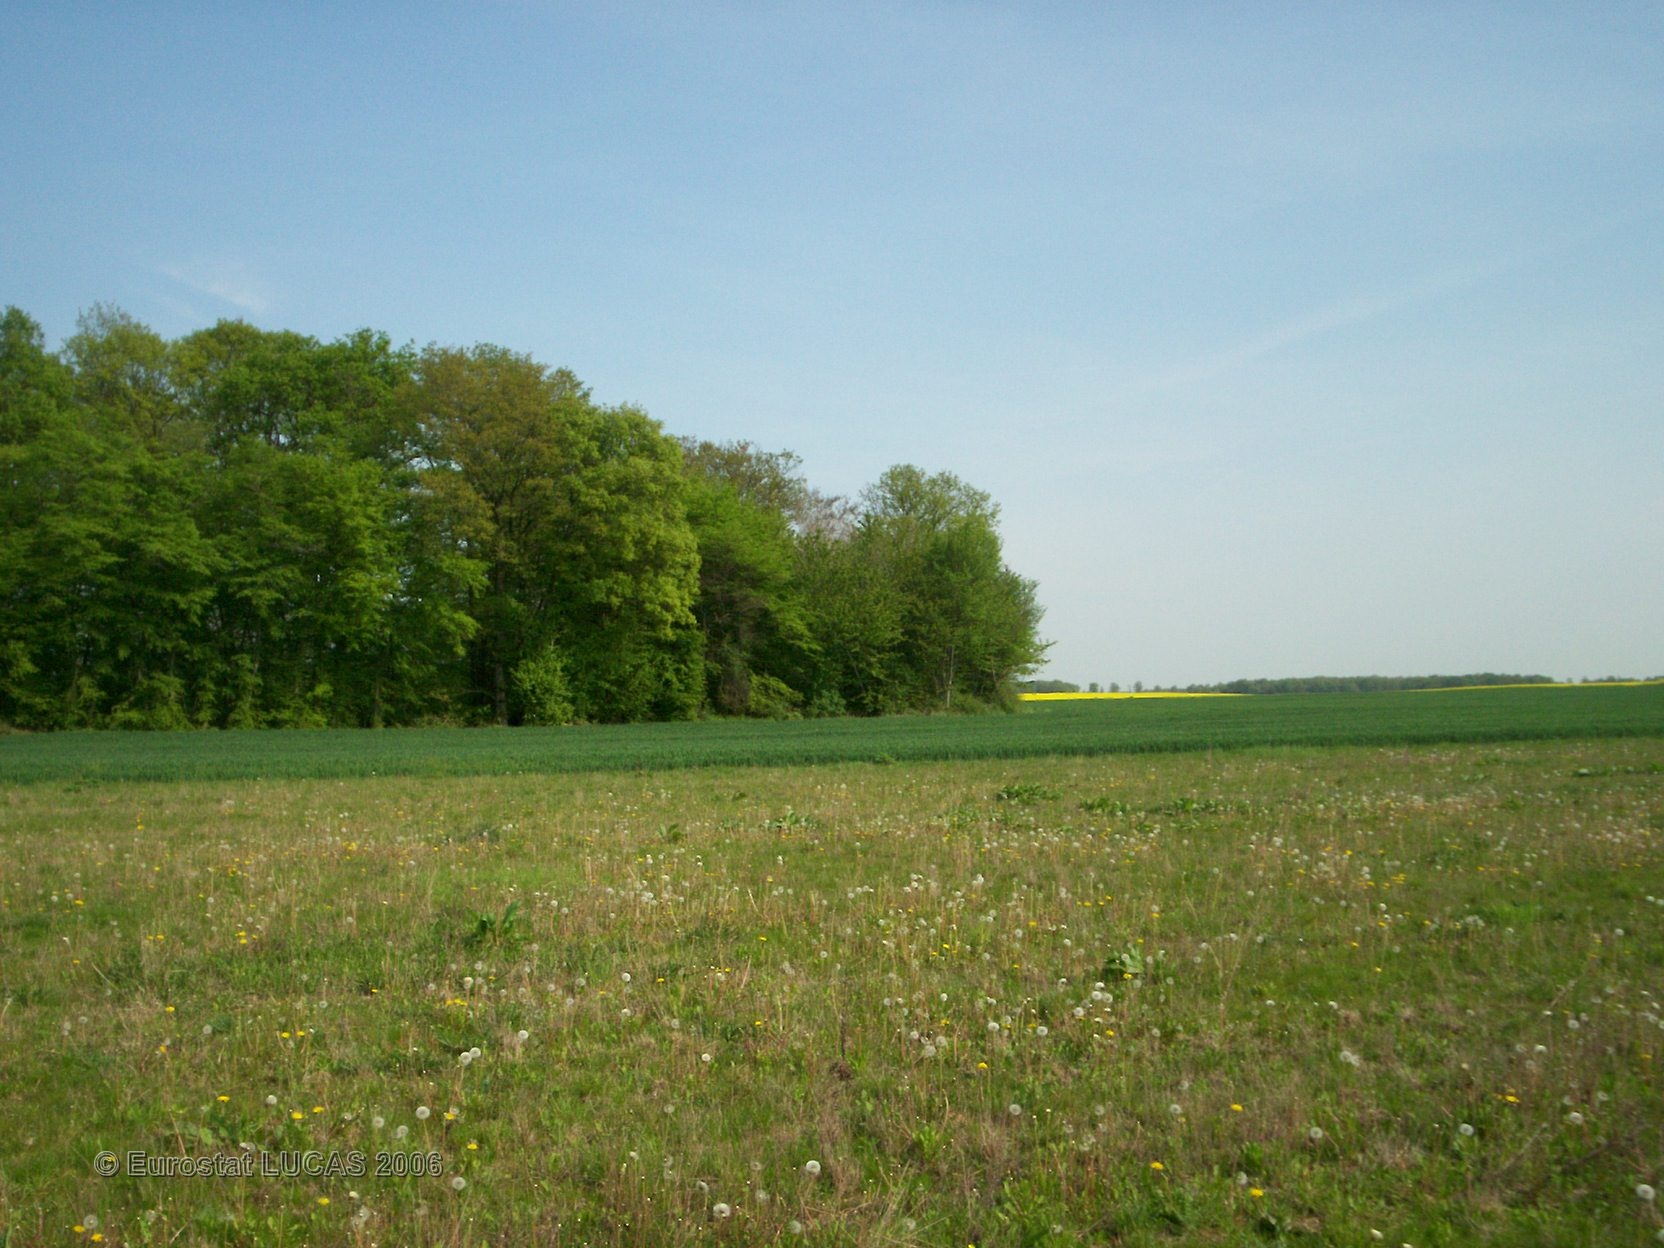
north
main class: Grassland
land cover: Grassland without tree/shrub cover
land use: Fallow land
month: May
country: FR
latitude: 48.0842
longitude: 2.8907
